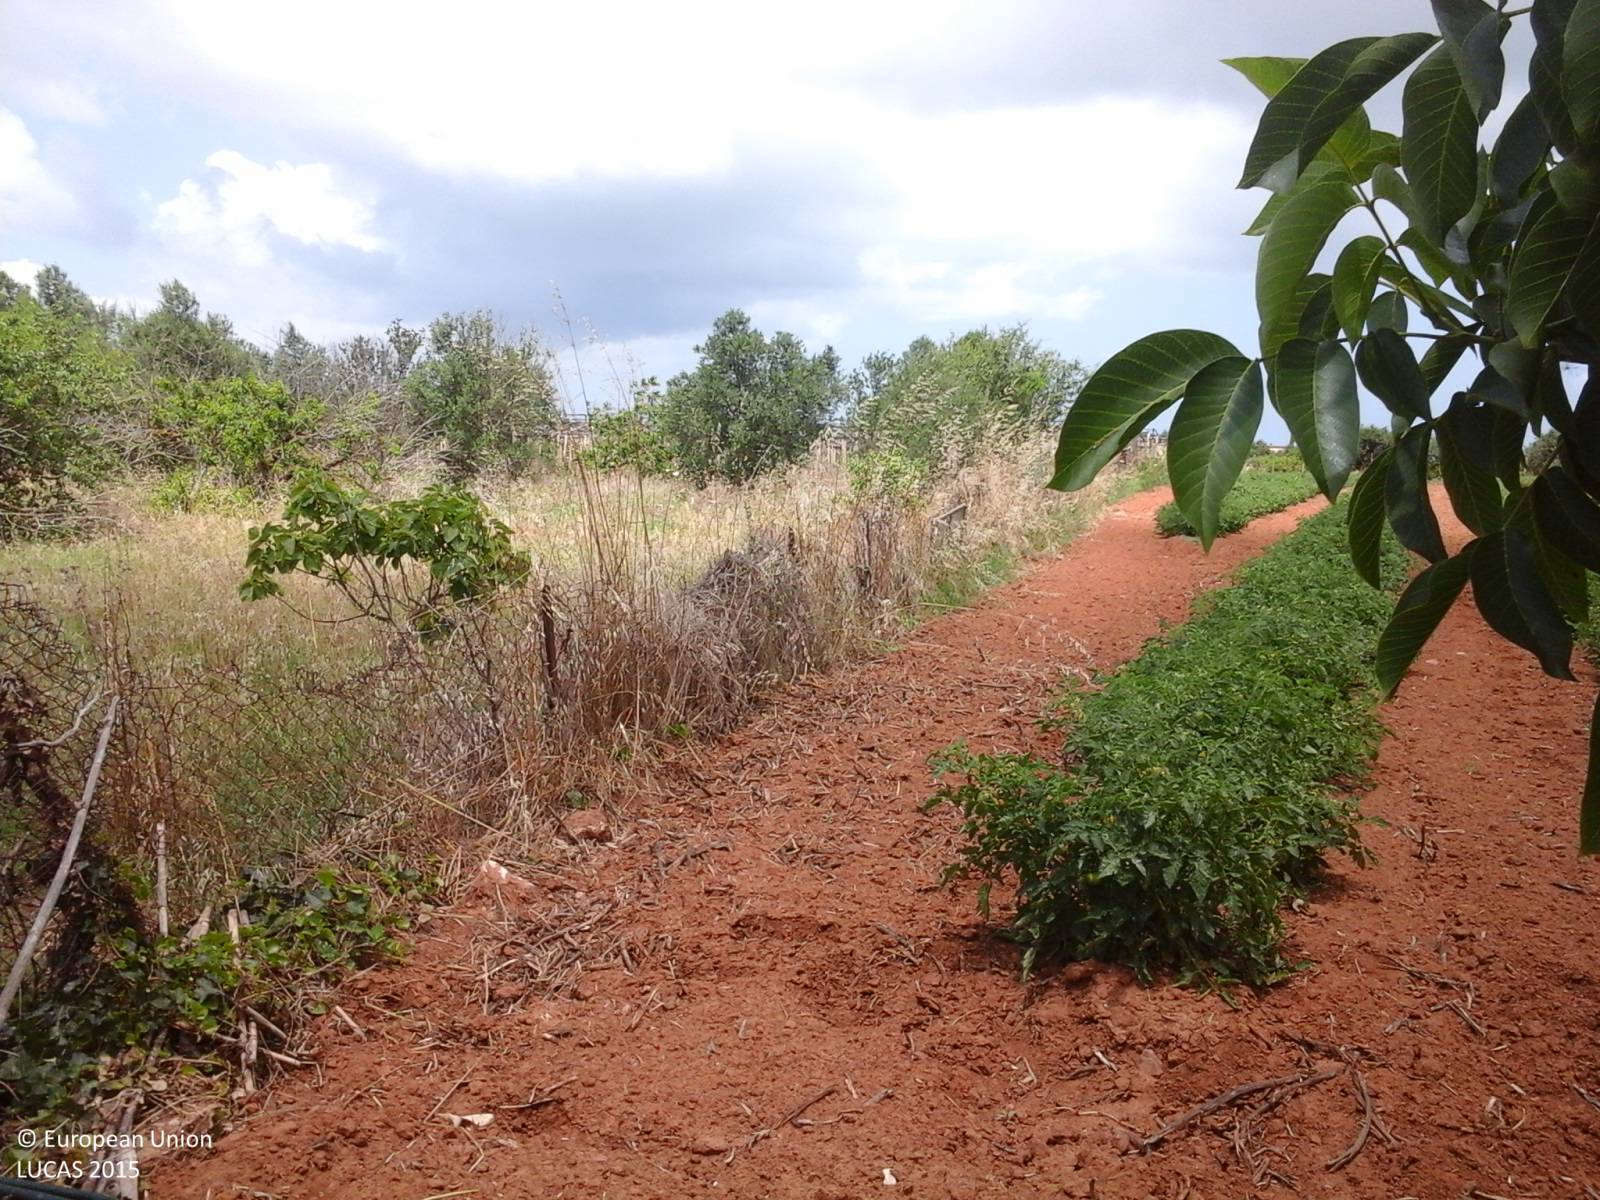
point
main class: Grassland
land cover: Grassland with sparse tree/shrub cover
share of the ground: > 75 %
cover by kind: herbaceous plants 85 %, shrubs 10 %, broadleaved forest trees 5 %
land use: Abandoned areas
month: June
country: IT
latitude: 38.0606
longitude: 13.0895
